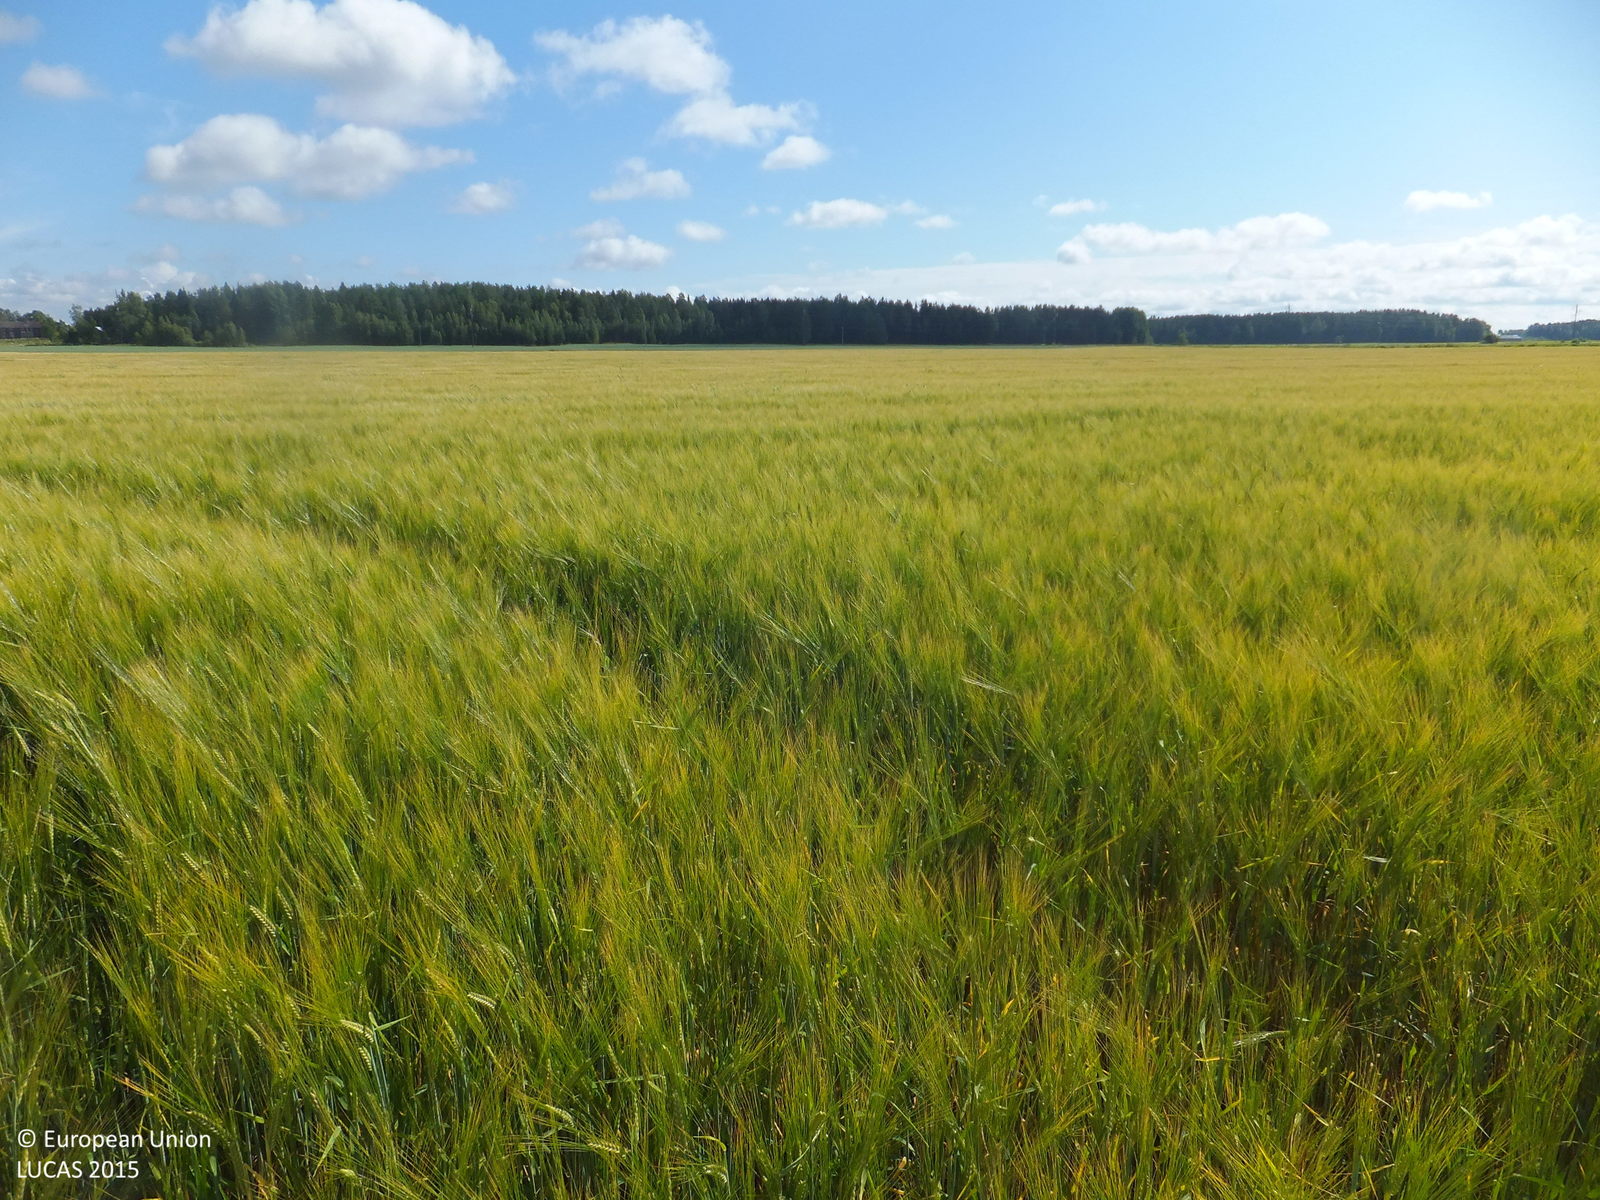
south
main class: Cropland
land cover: Barley
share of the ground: > 75 %
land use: Agriculture (excluding fallow land and kitchen gardens)
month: July
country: FI
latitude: 63.0348
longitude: 22.1242
